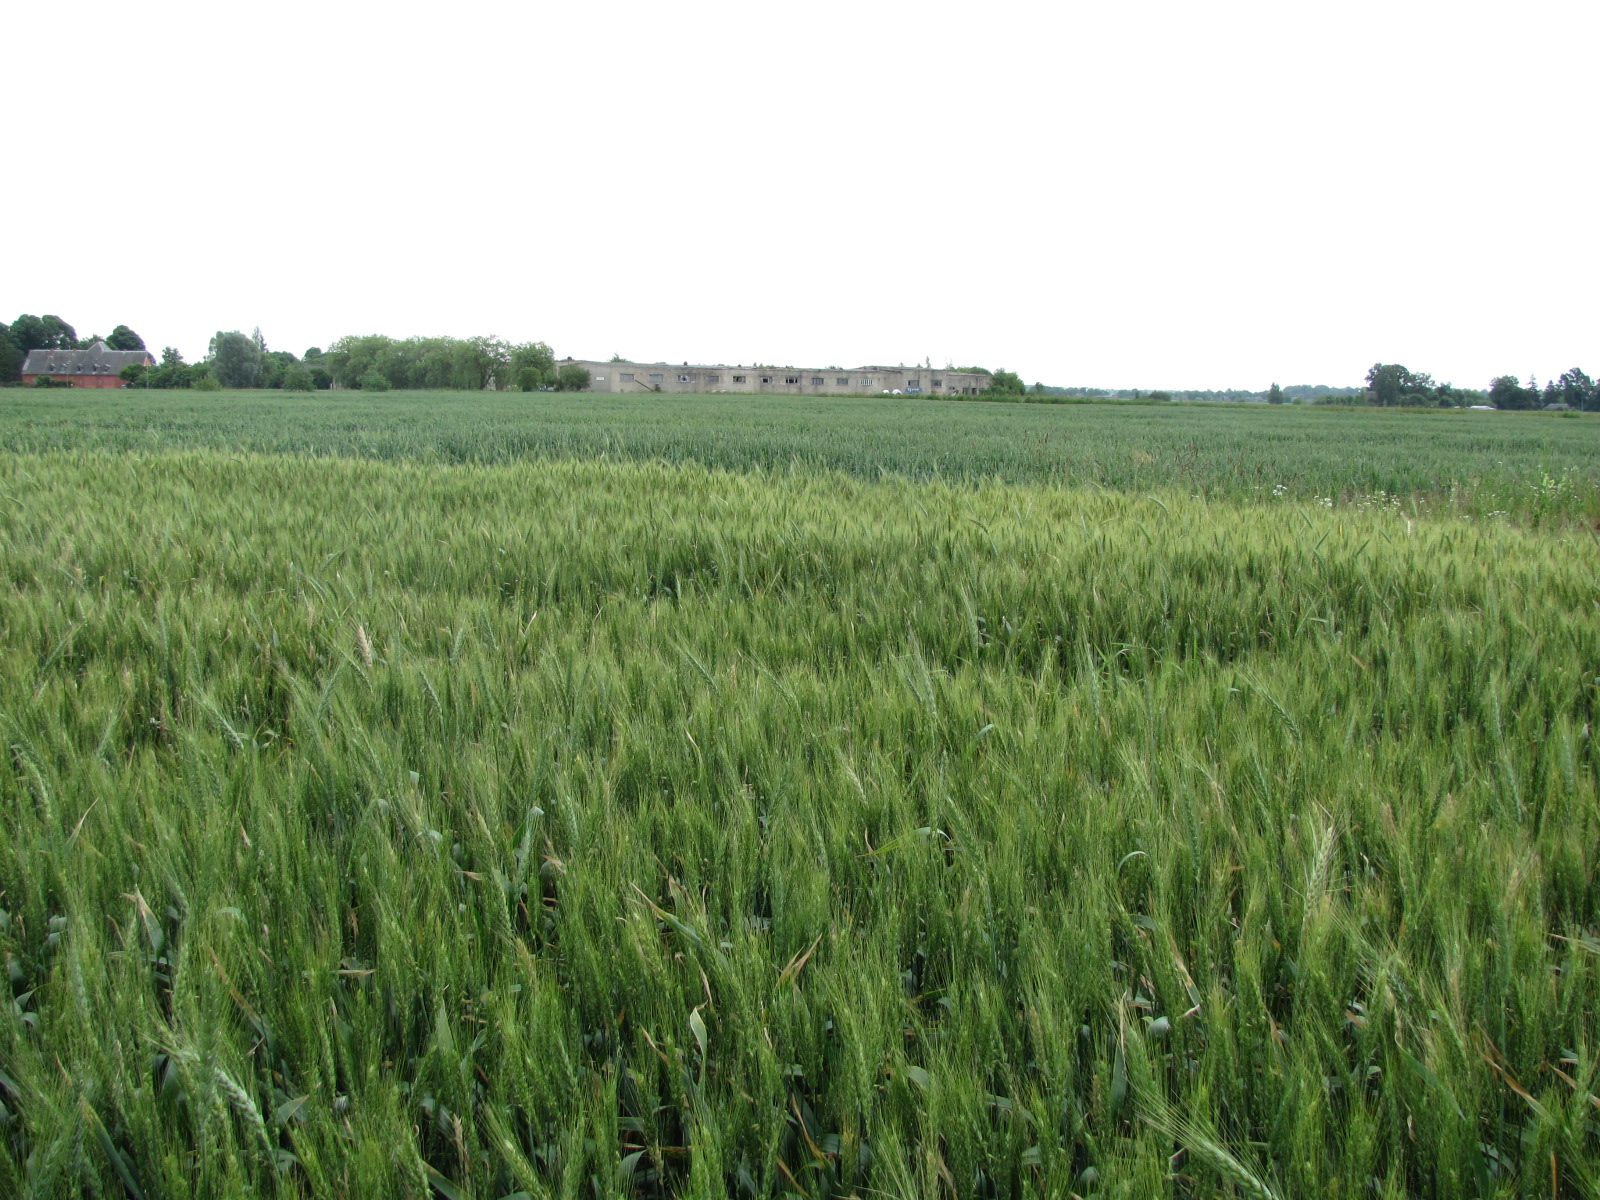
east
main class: Cropland
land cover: Triticale
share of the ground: > 75 %
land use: Agriculture (excluding fallow land and kitchen gardens)
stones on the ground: < 10 %
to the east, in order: Triticale; Common wheat; Tracks; Shruby margins; Ditches and canals; Common wheat
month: June
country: LV
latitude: 56.4229
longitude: 23.9791
